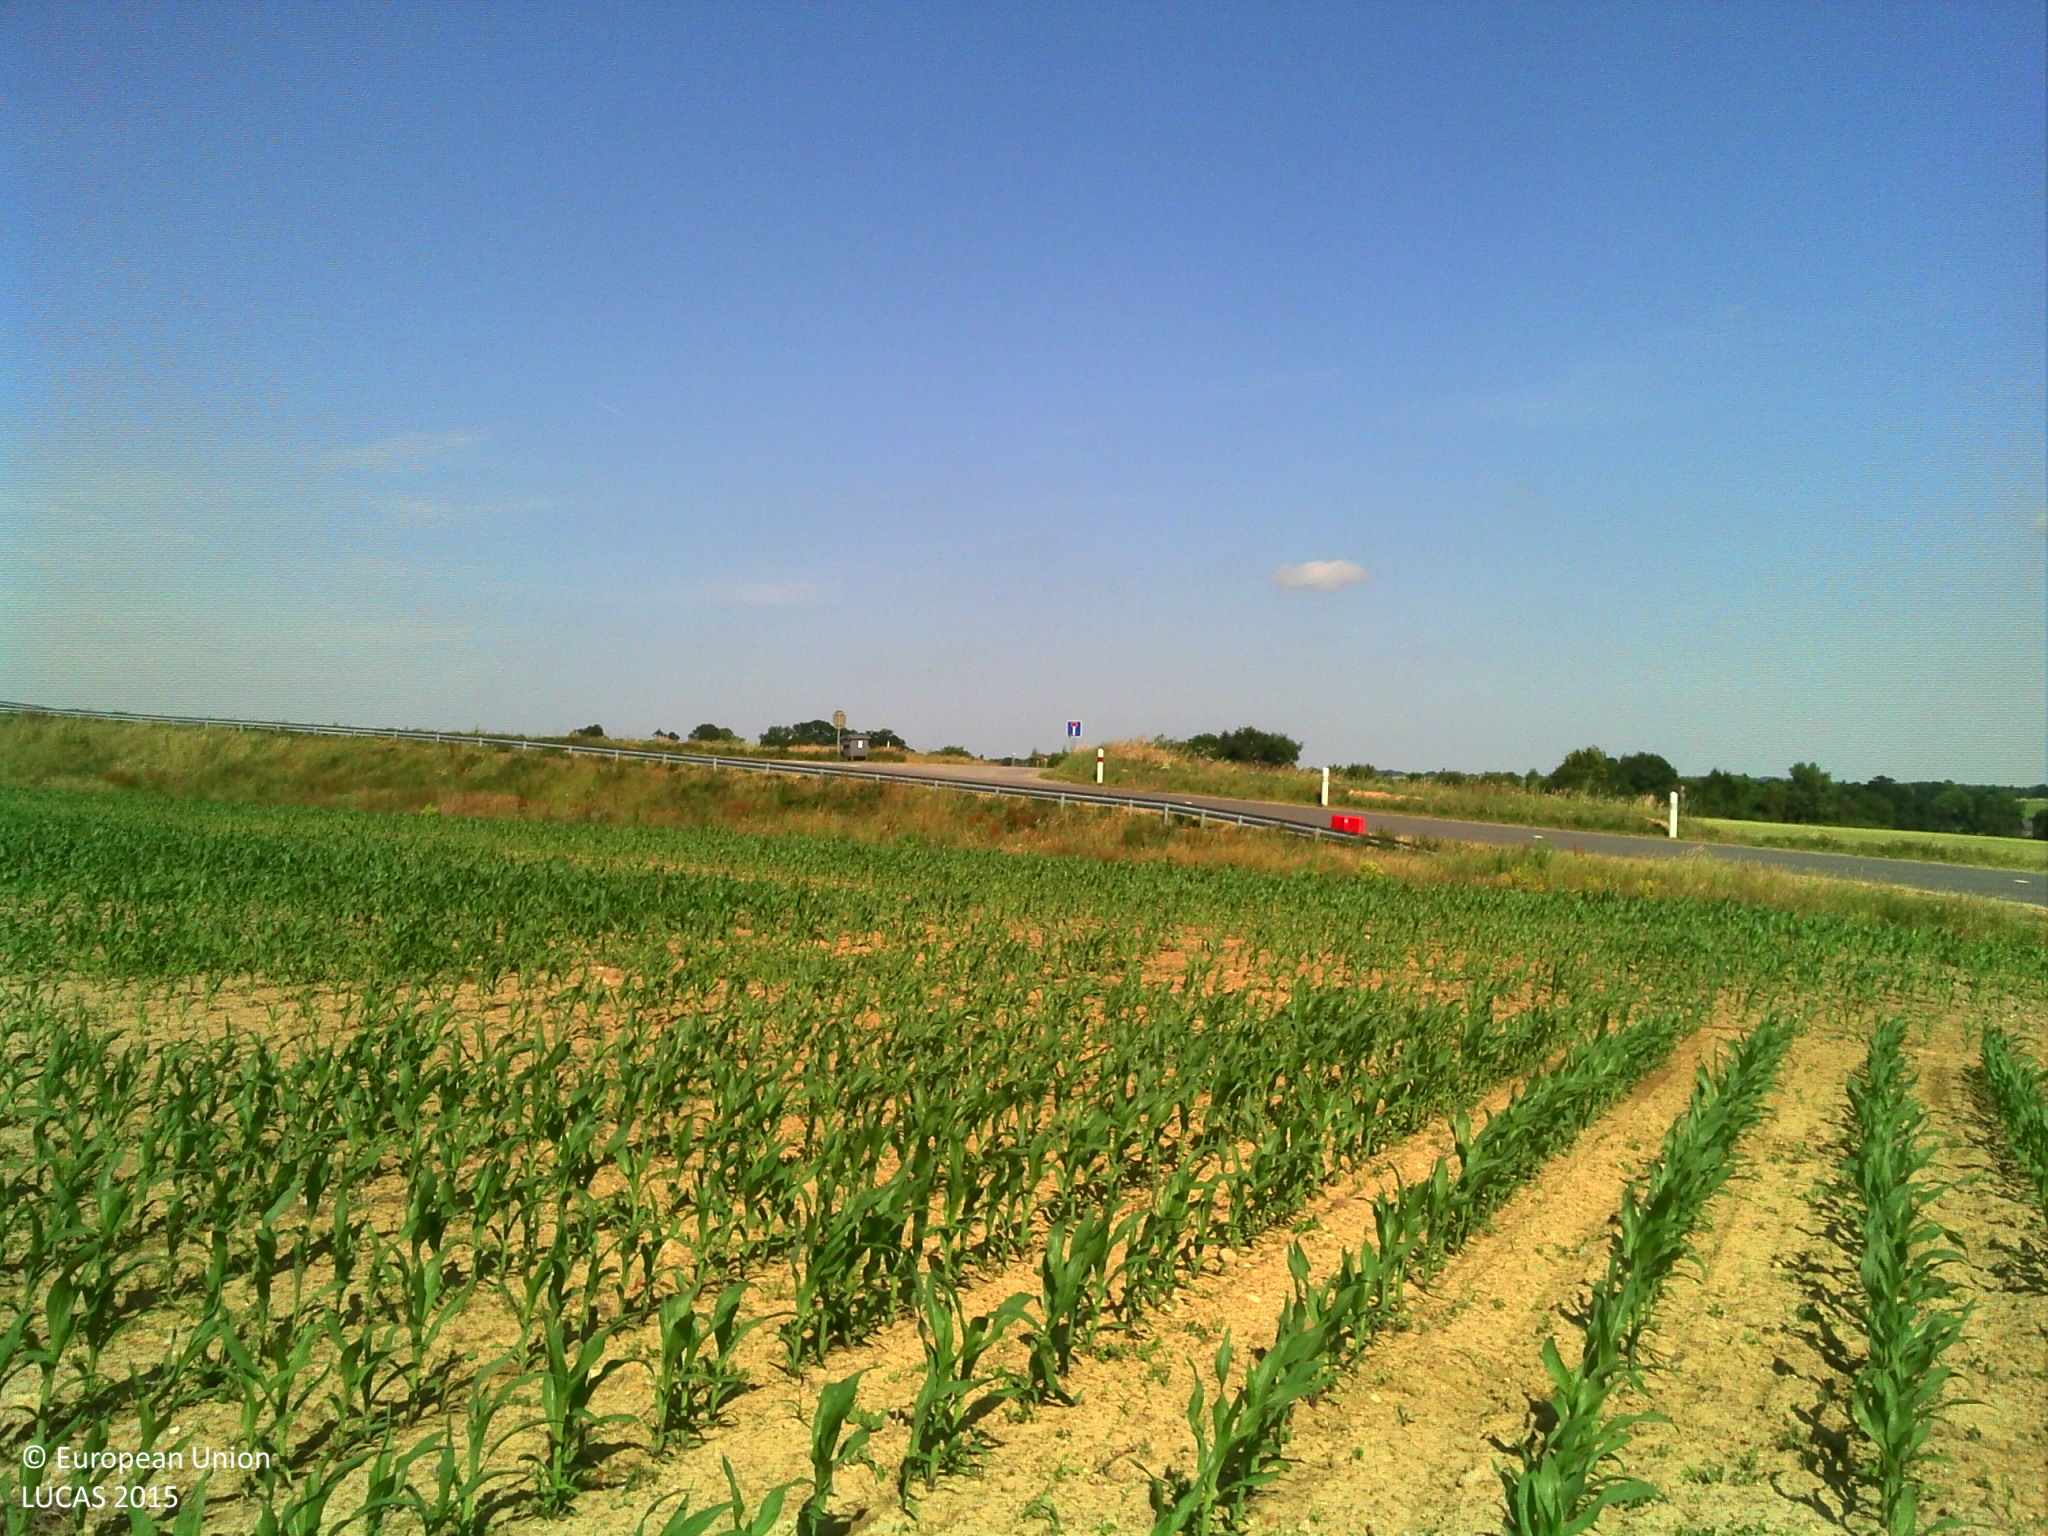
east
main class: Cropland
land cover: Maize
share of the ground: 10 - 25 %
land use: Agriculture (excluding fallow land and kitchen gardens)
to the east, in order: Maize; Grass margins; Rivers and streams; Grassland without tree/shrub cover; Fences; Grass margins; Paved roads, cycling and walking lanes; Grassland without tree/shrub cover; Maize; Common wheat
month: June
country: FR
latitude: 48.0623
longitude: -1.4370
